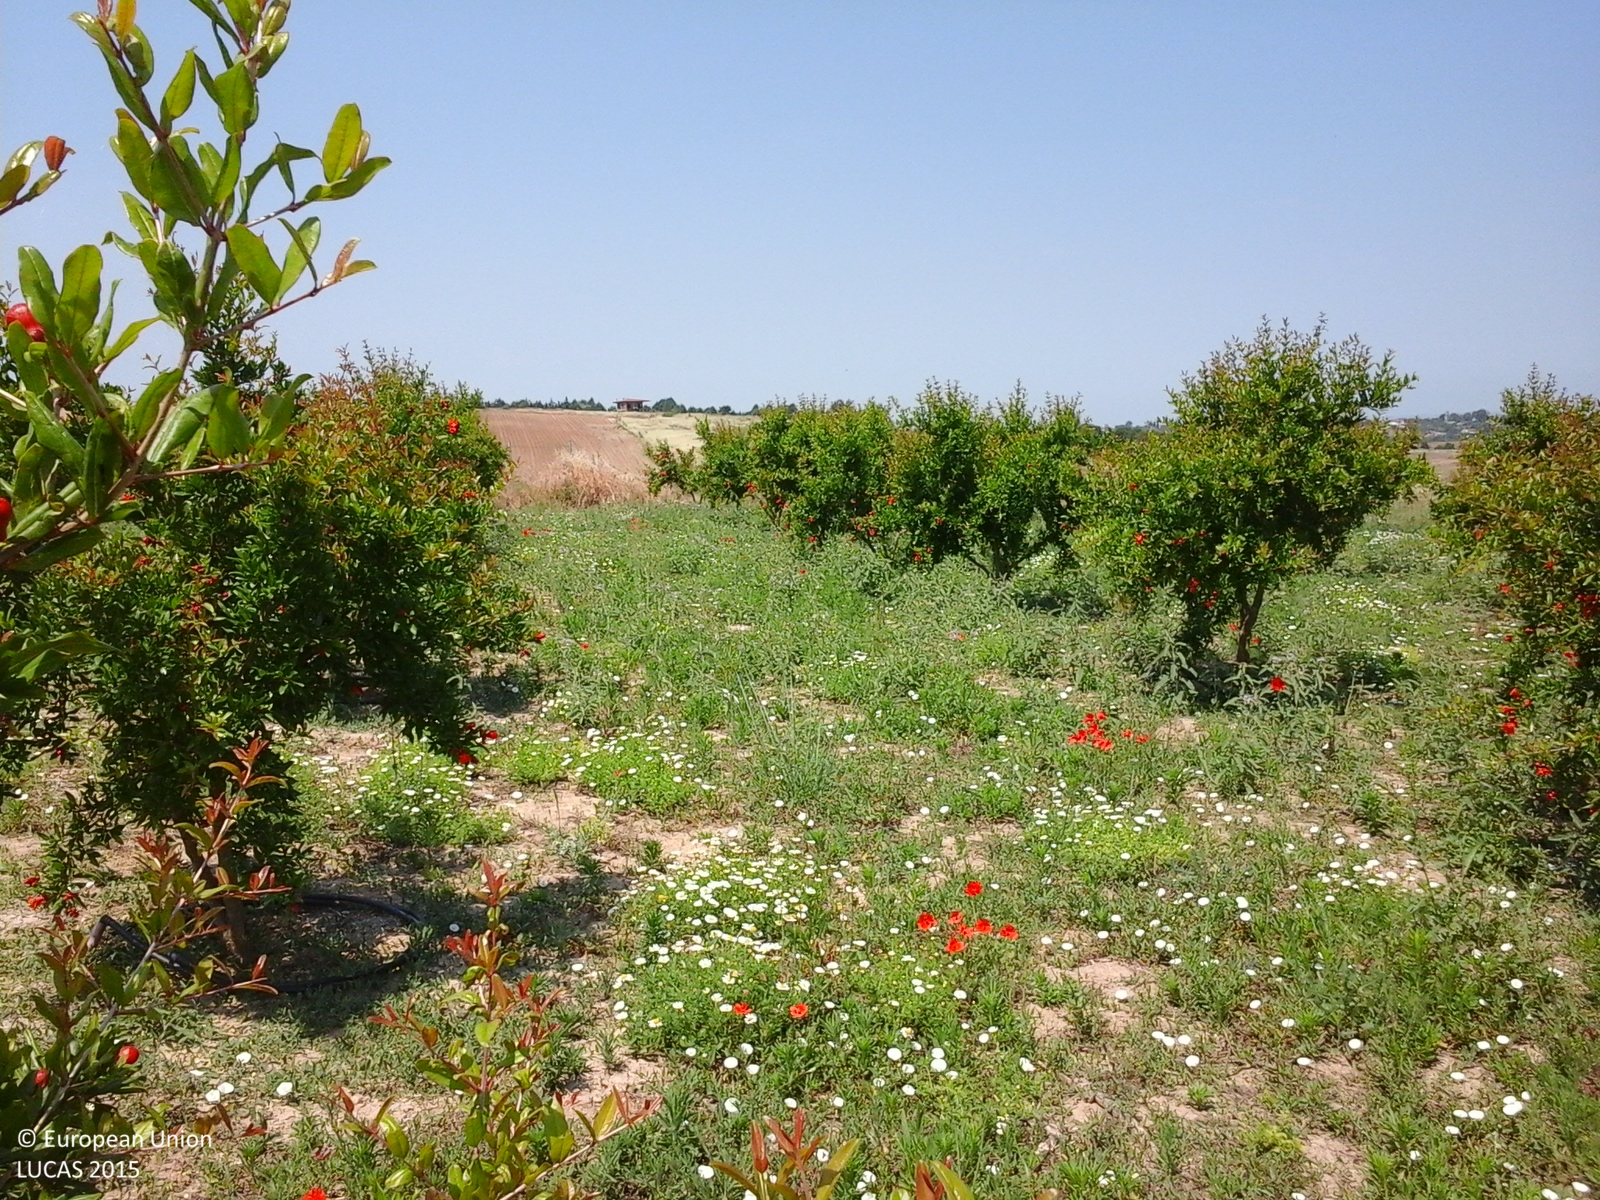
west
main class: Cropland
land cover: Other fruit trees and berries
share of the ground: 50 - 75 %
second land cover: Spontaneously vegetated surfaces
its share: > 75 %
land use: Agriculture (excluding fallow land and kitchen gardens)
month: June
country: GR
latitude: 40.4849
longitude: 22.9469
